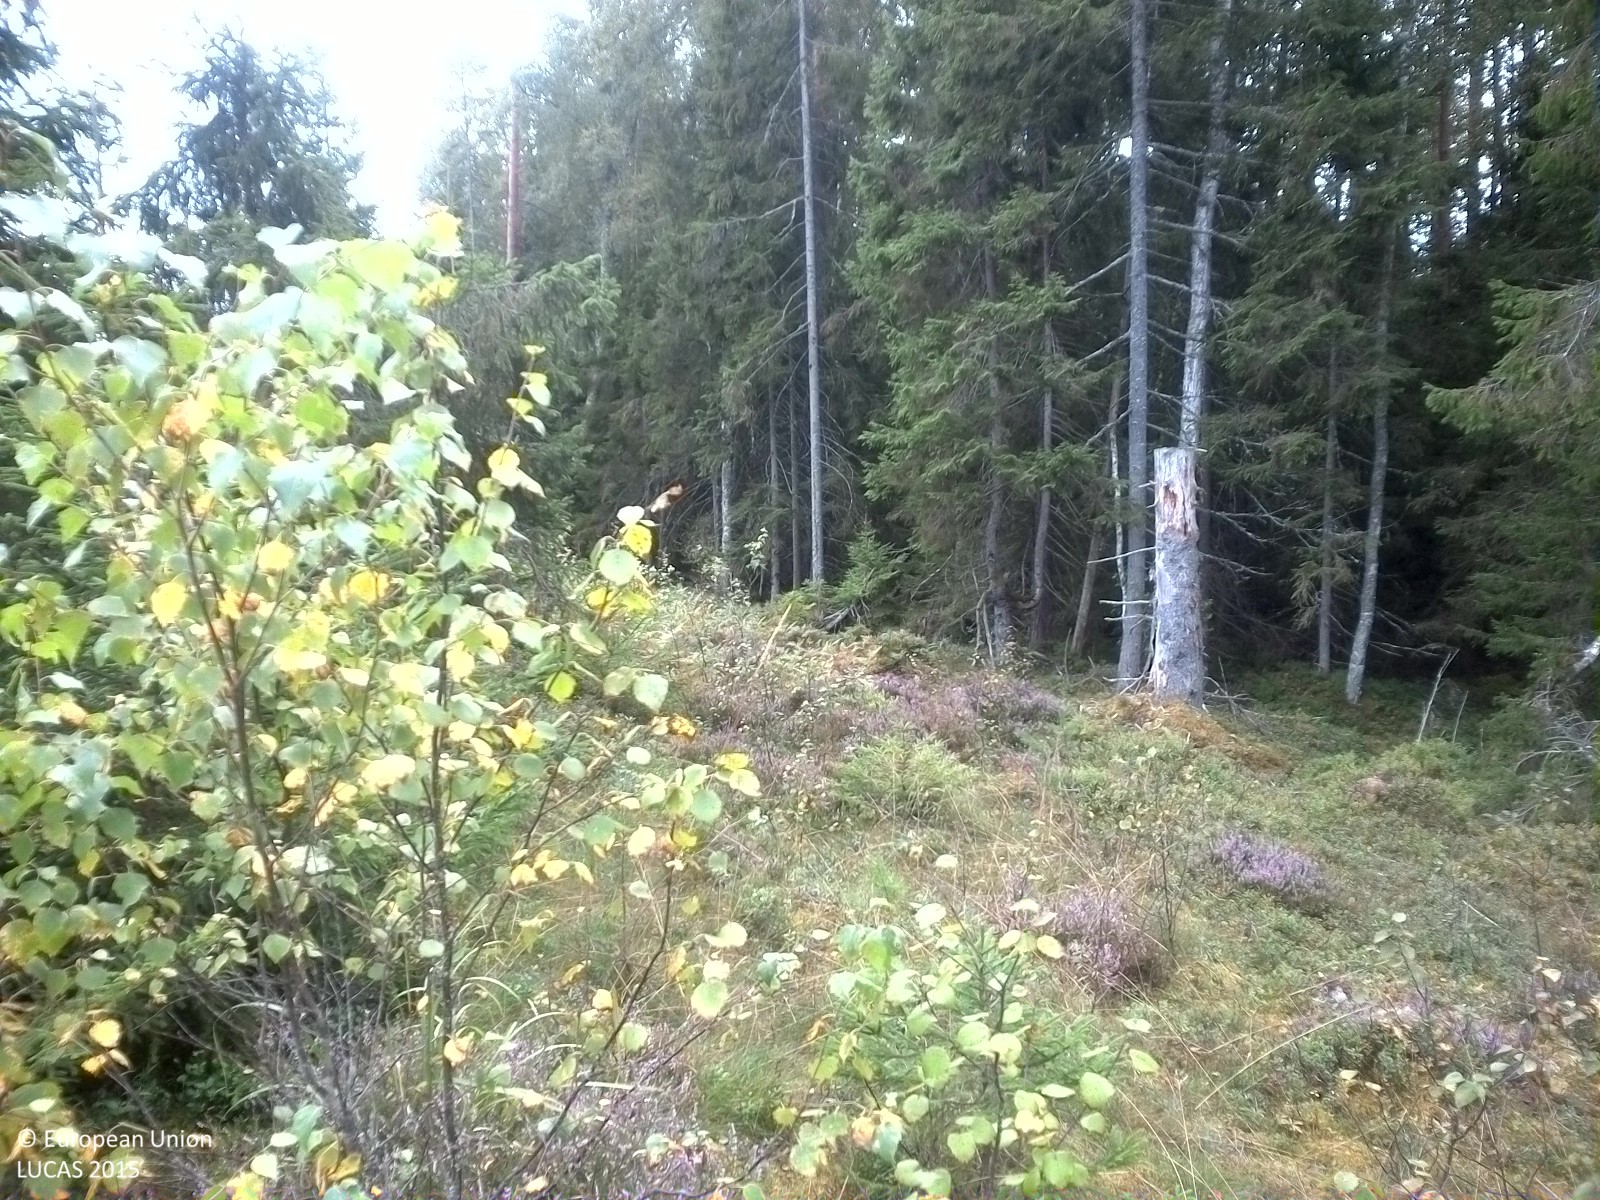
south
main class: Woodland
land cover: Spruce dominated mixed woodland
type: boreal forest
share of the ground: 50 - 75 %
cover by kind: coniferous forest trees 35 %, broadleaved forest trees 25 %, herbaceous plants 20 %, shrubs 10 %, lichens and mosses 10 %
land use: Forestry
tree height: < 5 m
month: August
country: SE
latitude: 59.3539
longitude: 15.8841
